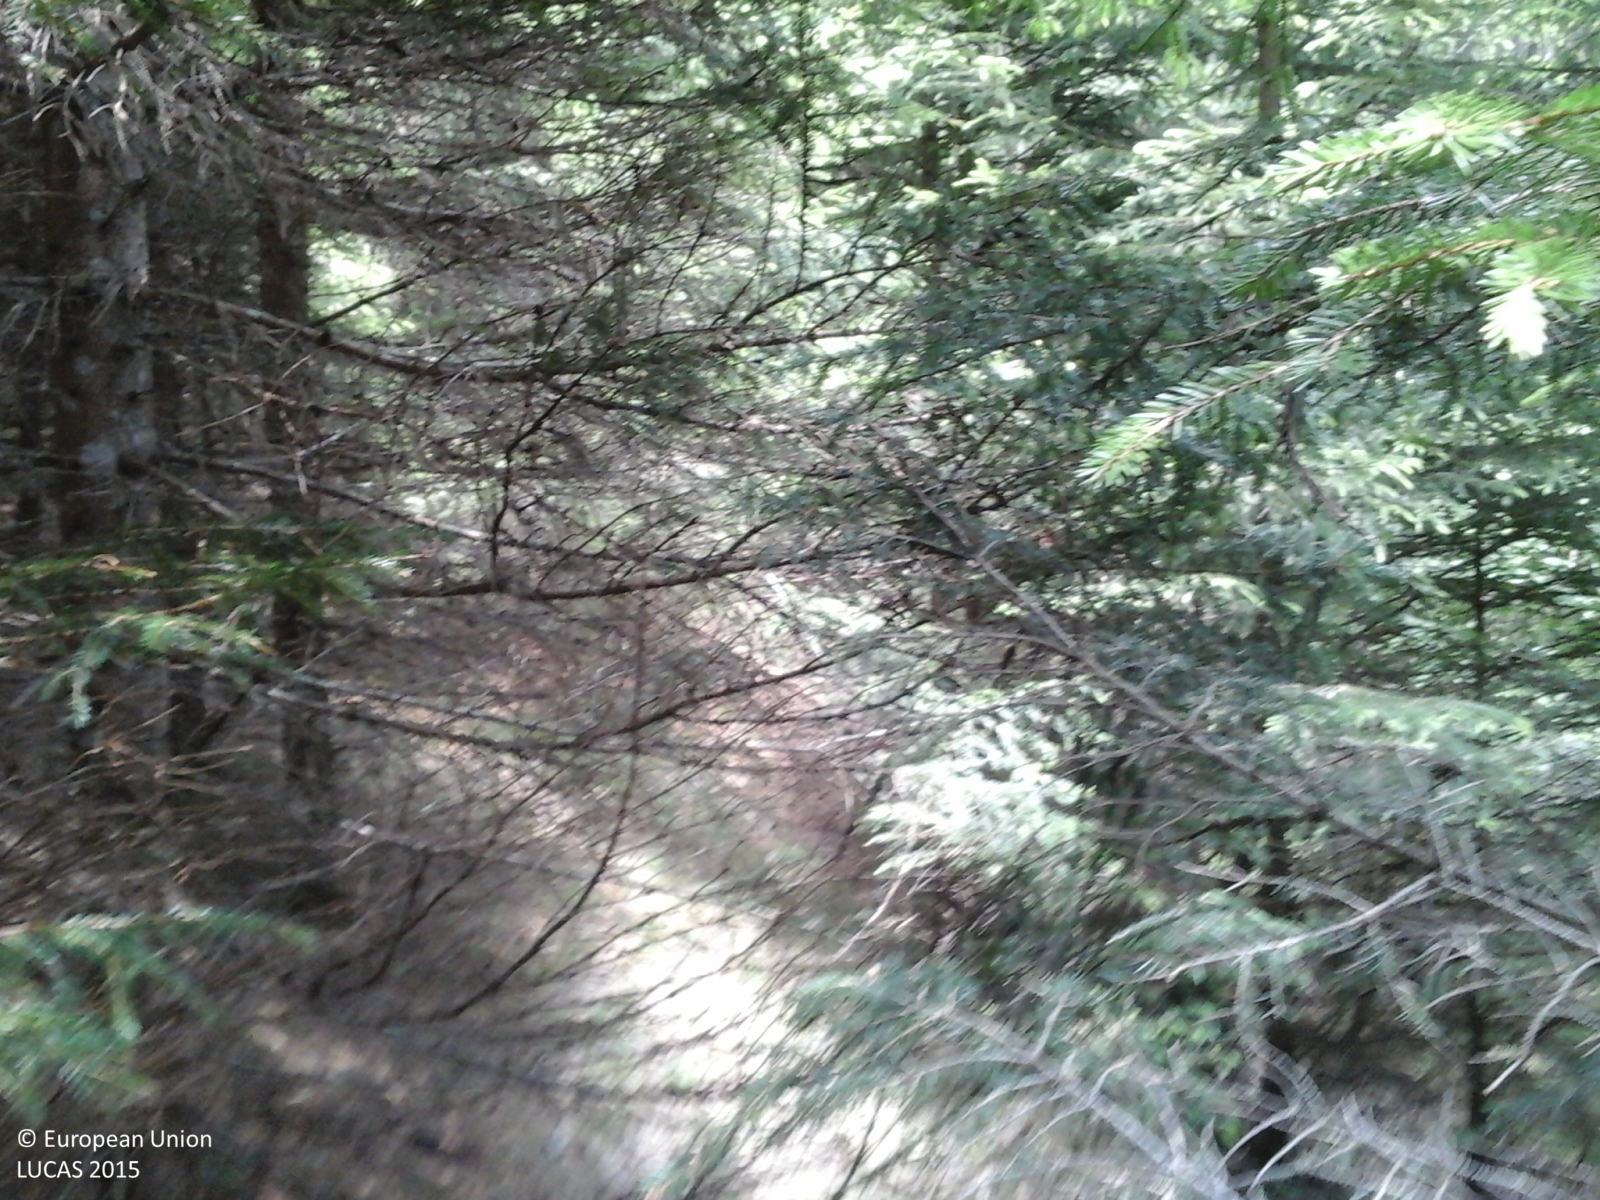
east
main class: Woodland
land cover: Spruce dominated coniferous woodland
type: alpine coniferous forest
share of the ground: > 75 %
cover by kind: coniferous forest trees 100 %
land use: Forestry
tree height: > 5 m
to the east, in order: Spruce dominated coniferous woodland; Broadleaved woodland; Paved roads, cycling and walking lanes
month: May
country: IT
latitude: 46.1892
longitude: 11.9540
